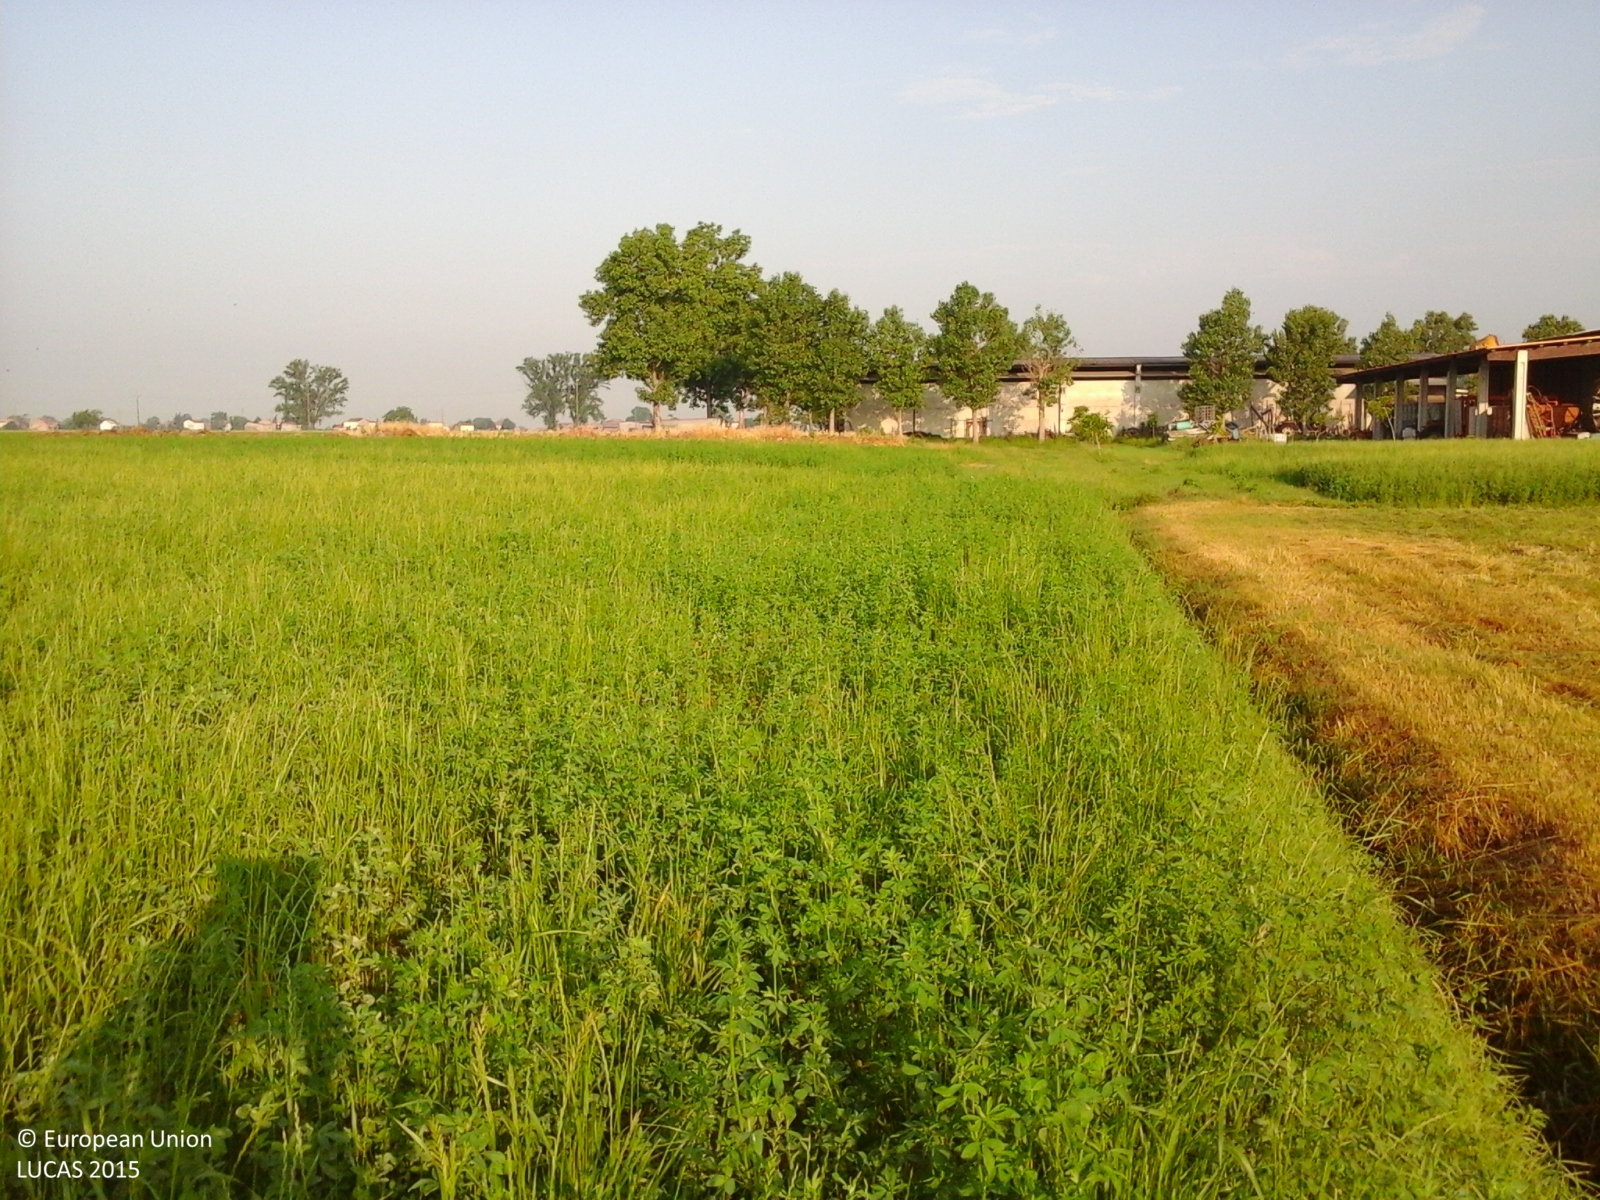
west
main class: Cropland
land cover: Lucerne
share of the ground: > 75 %
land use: Agriculture (excluding fallow land and kitchen gardens)
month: June
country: IT
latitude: 44.9635
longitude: 10.1645
